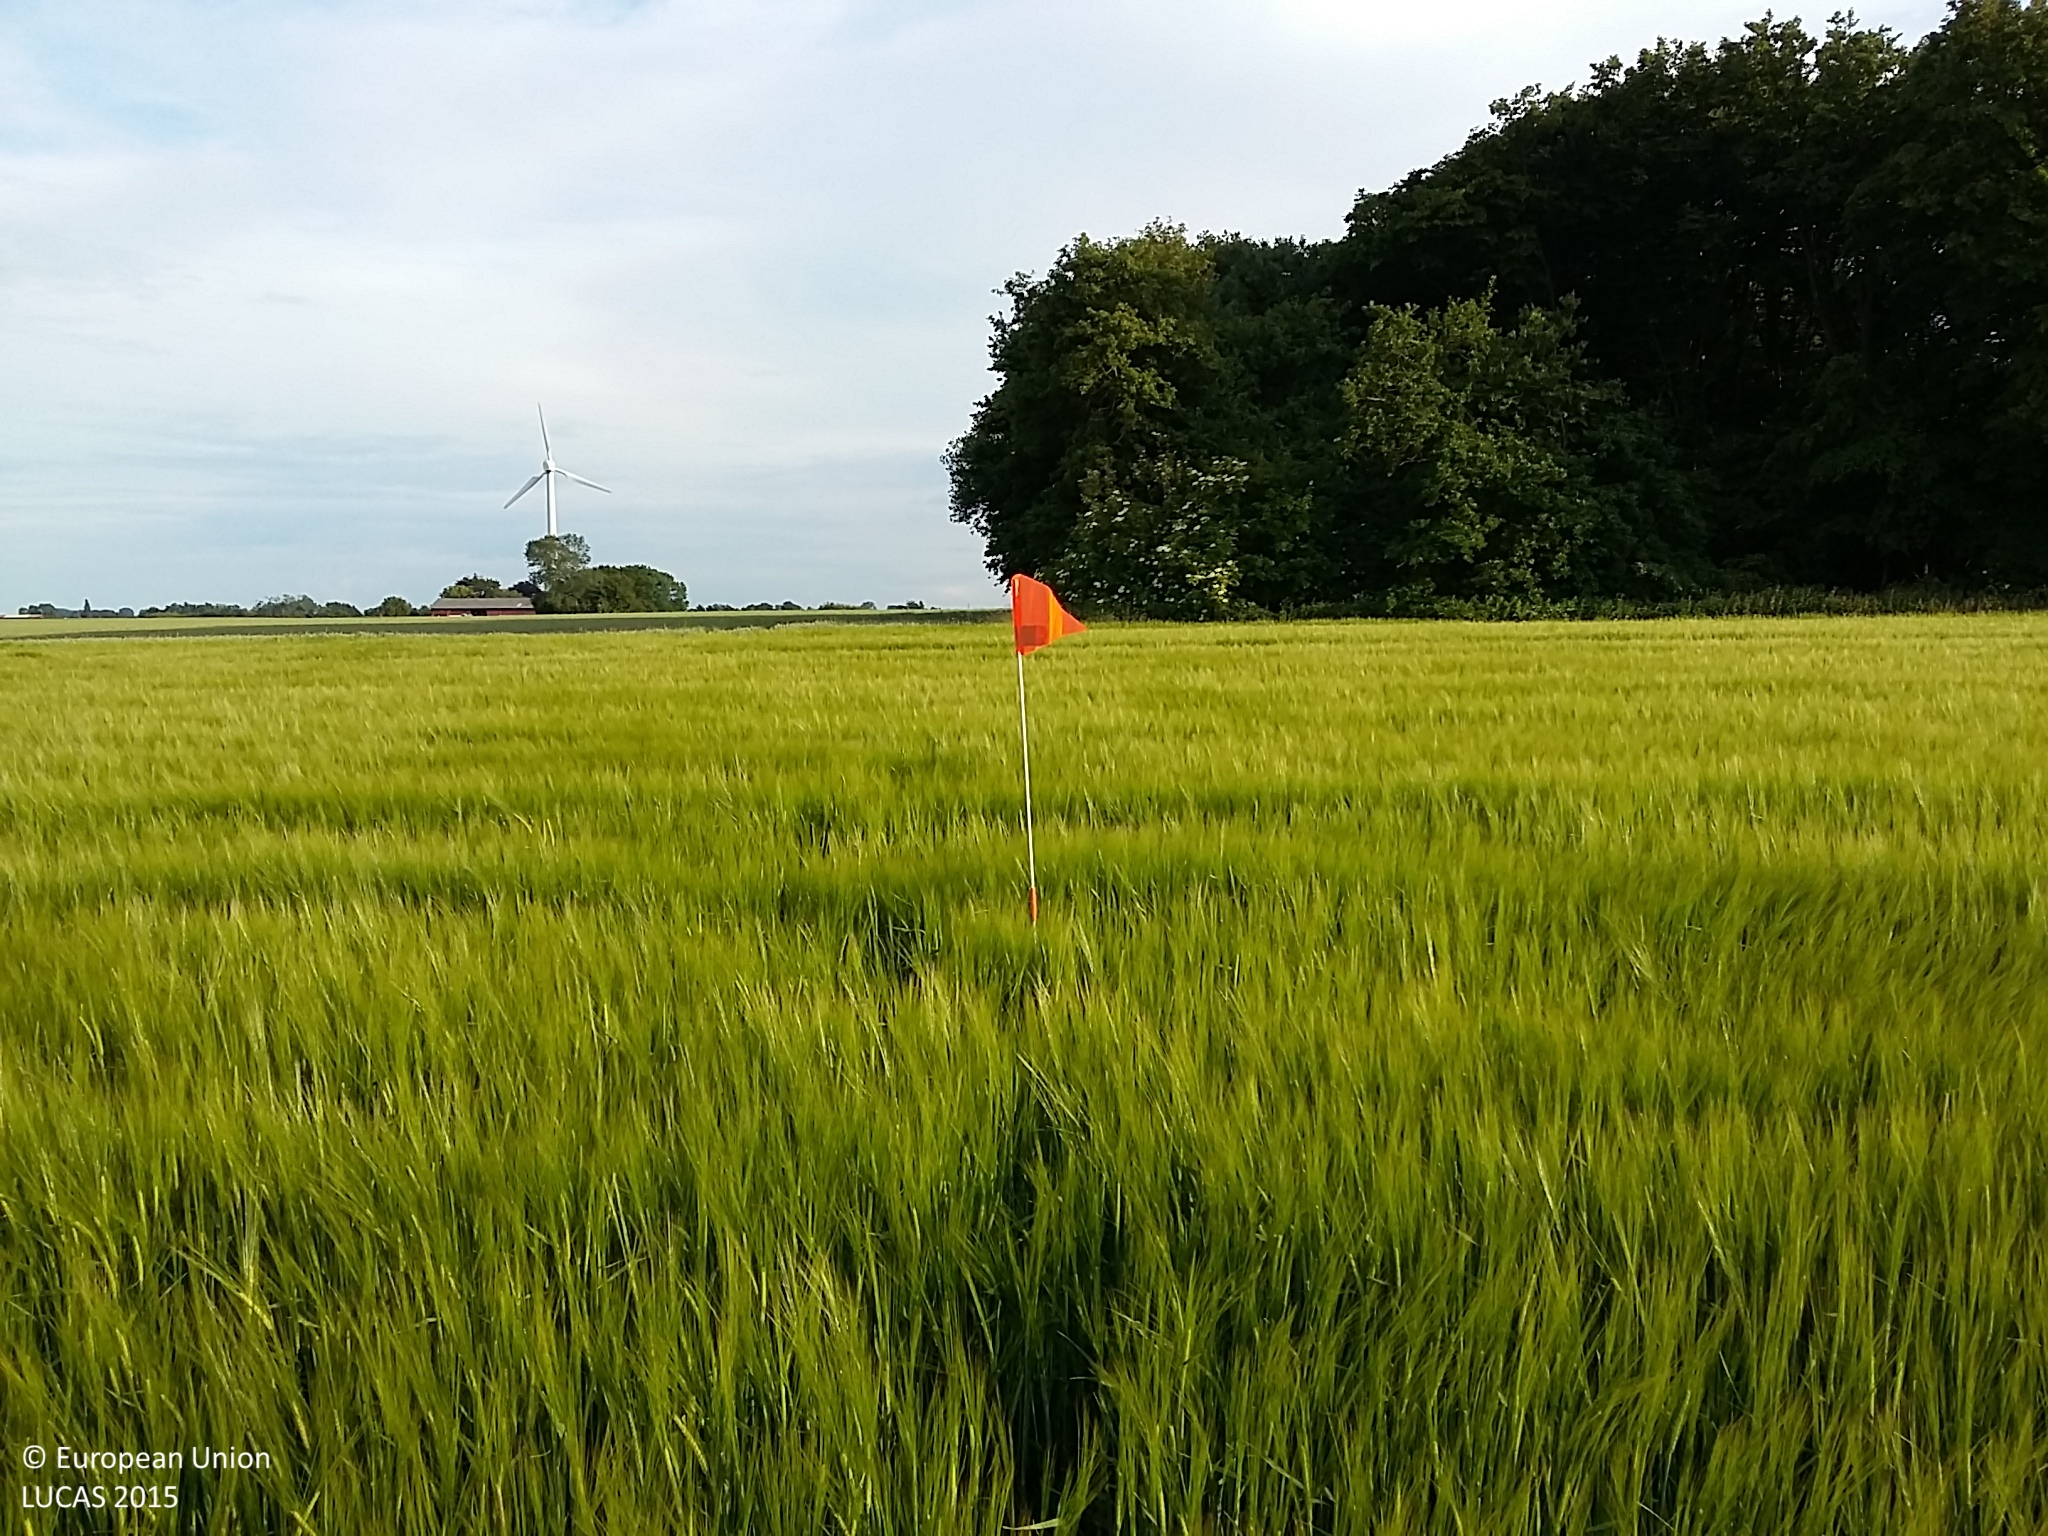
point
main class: Cropland
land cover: Barley
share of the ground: > 75 %
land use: Agriculture (excluding fallow land and kitchen gardens)
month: June
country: DK
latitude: 54.7598
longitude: 11.4132
